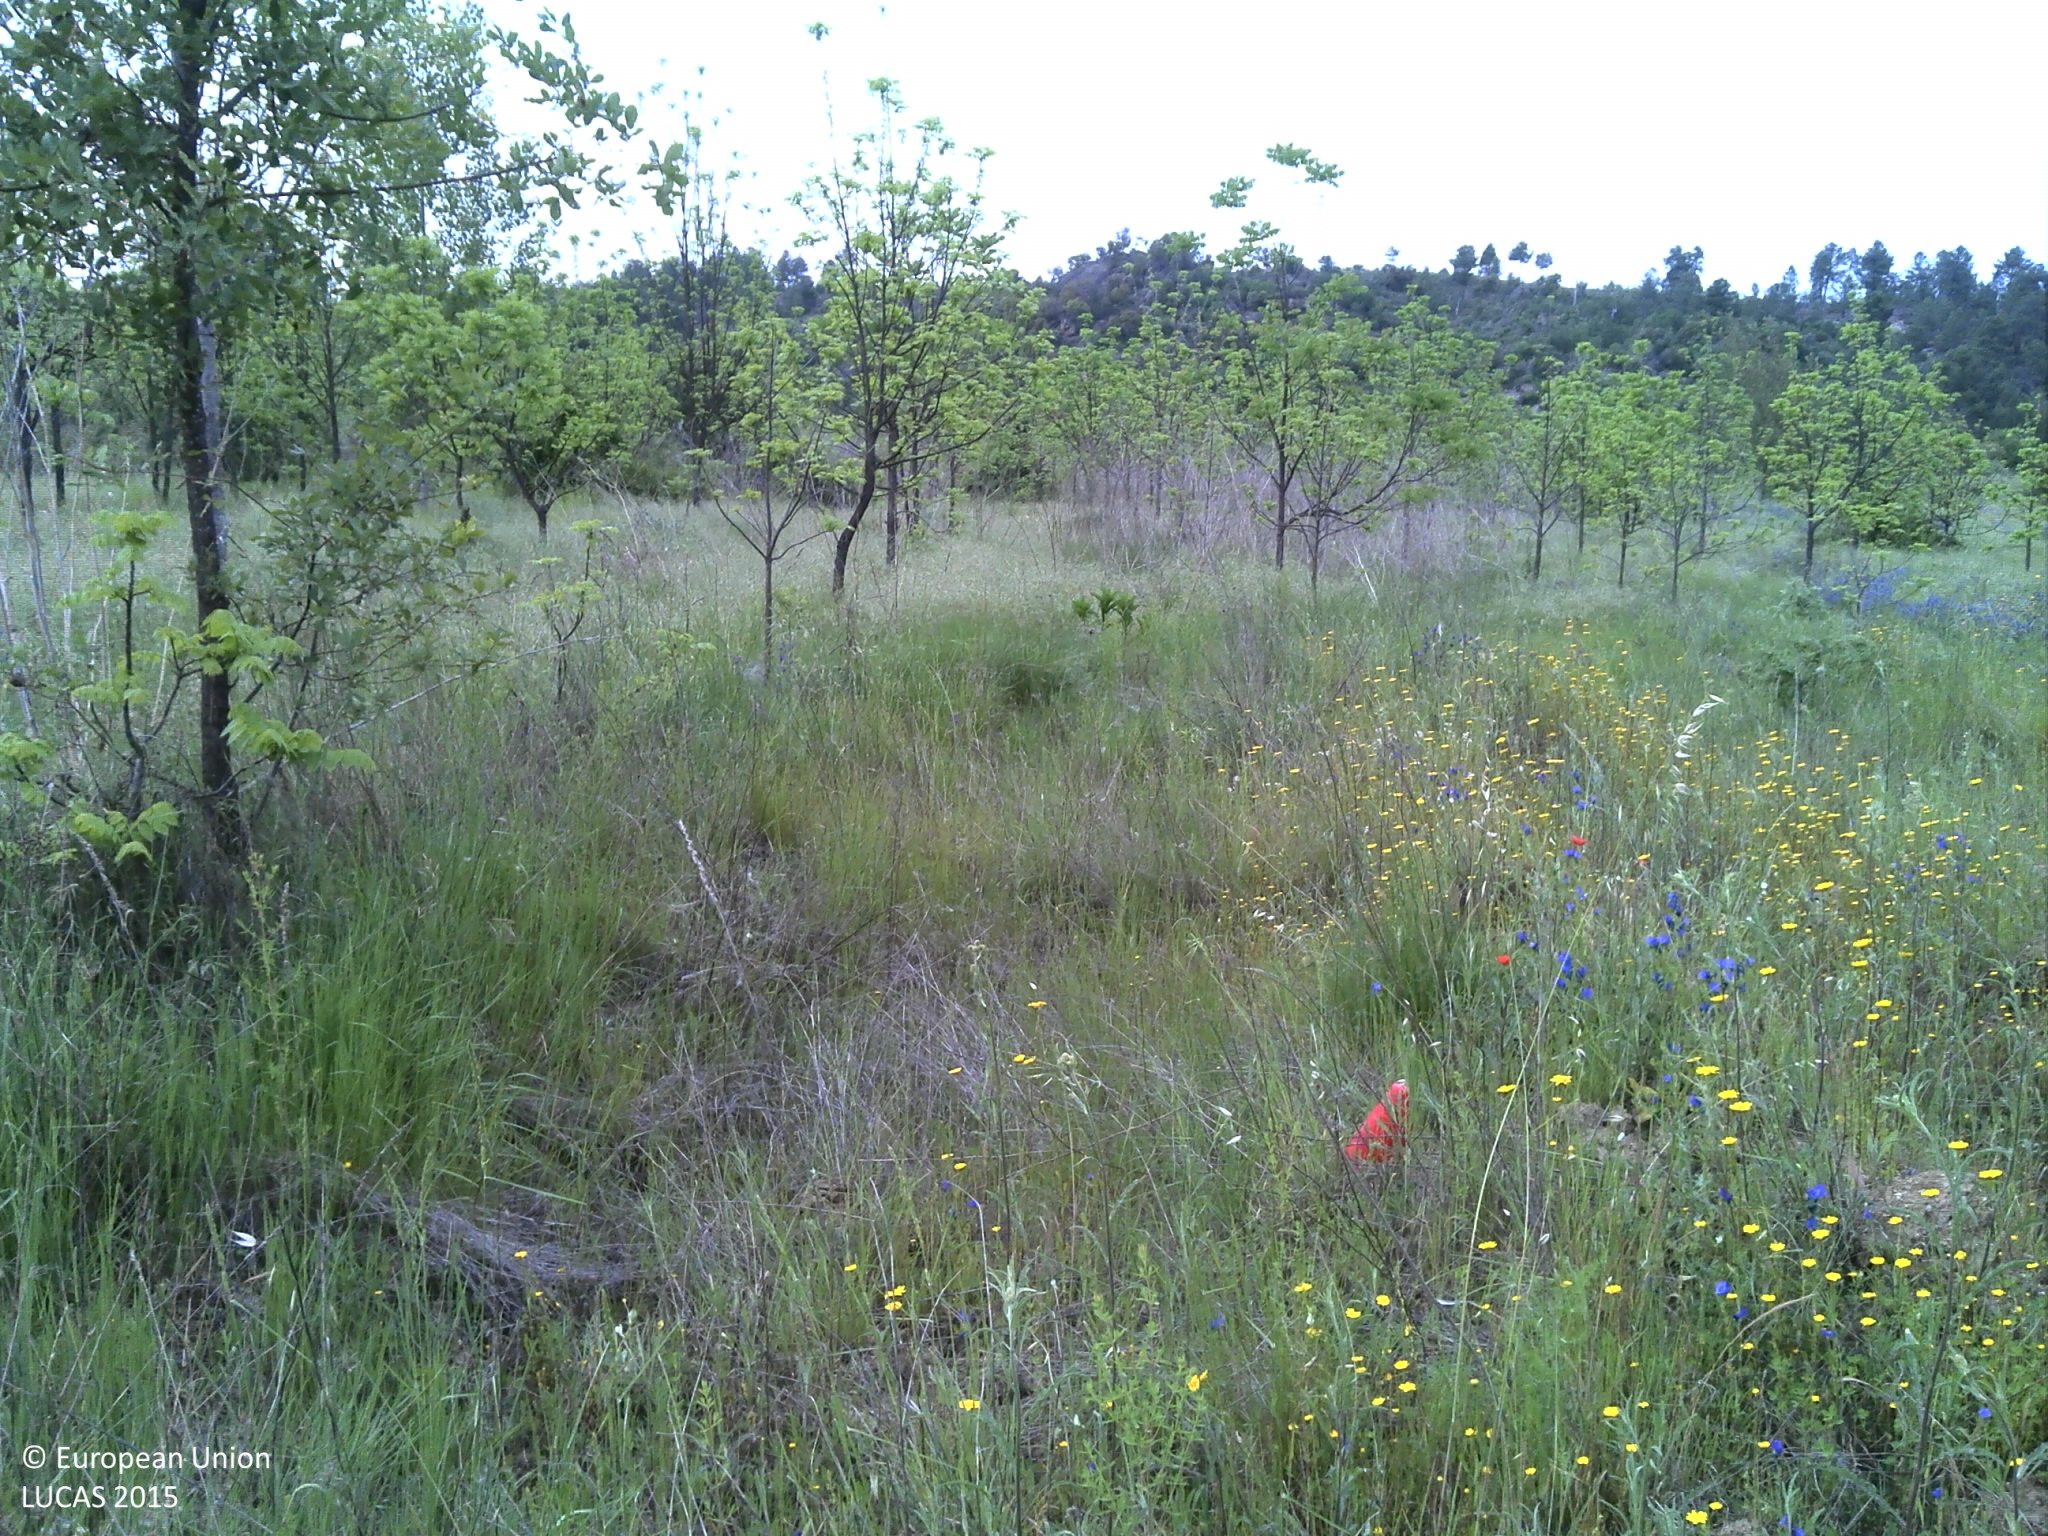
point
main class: Woodland
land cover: Broadleaved woodland
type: exotic forest
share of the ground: 10 - 25 %
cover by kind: herbaceous plants 70 %, broadleaved forest trees 20 %, unconsolidated bare surface 10 %
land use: Forestry
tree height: < 5 m
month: May
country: PT
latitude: 41.6380
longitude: -7.1556
